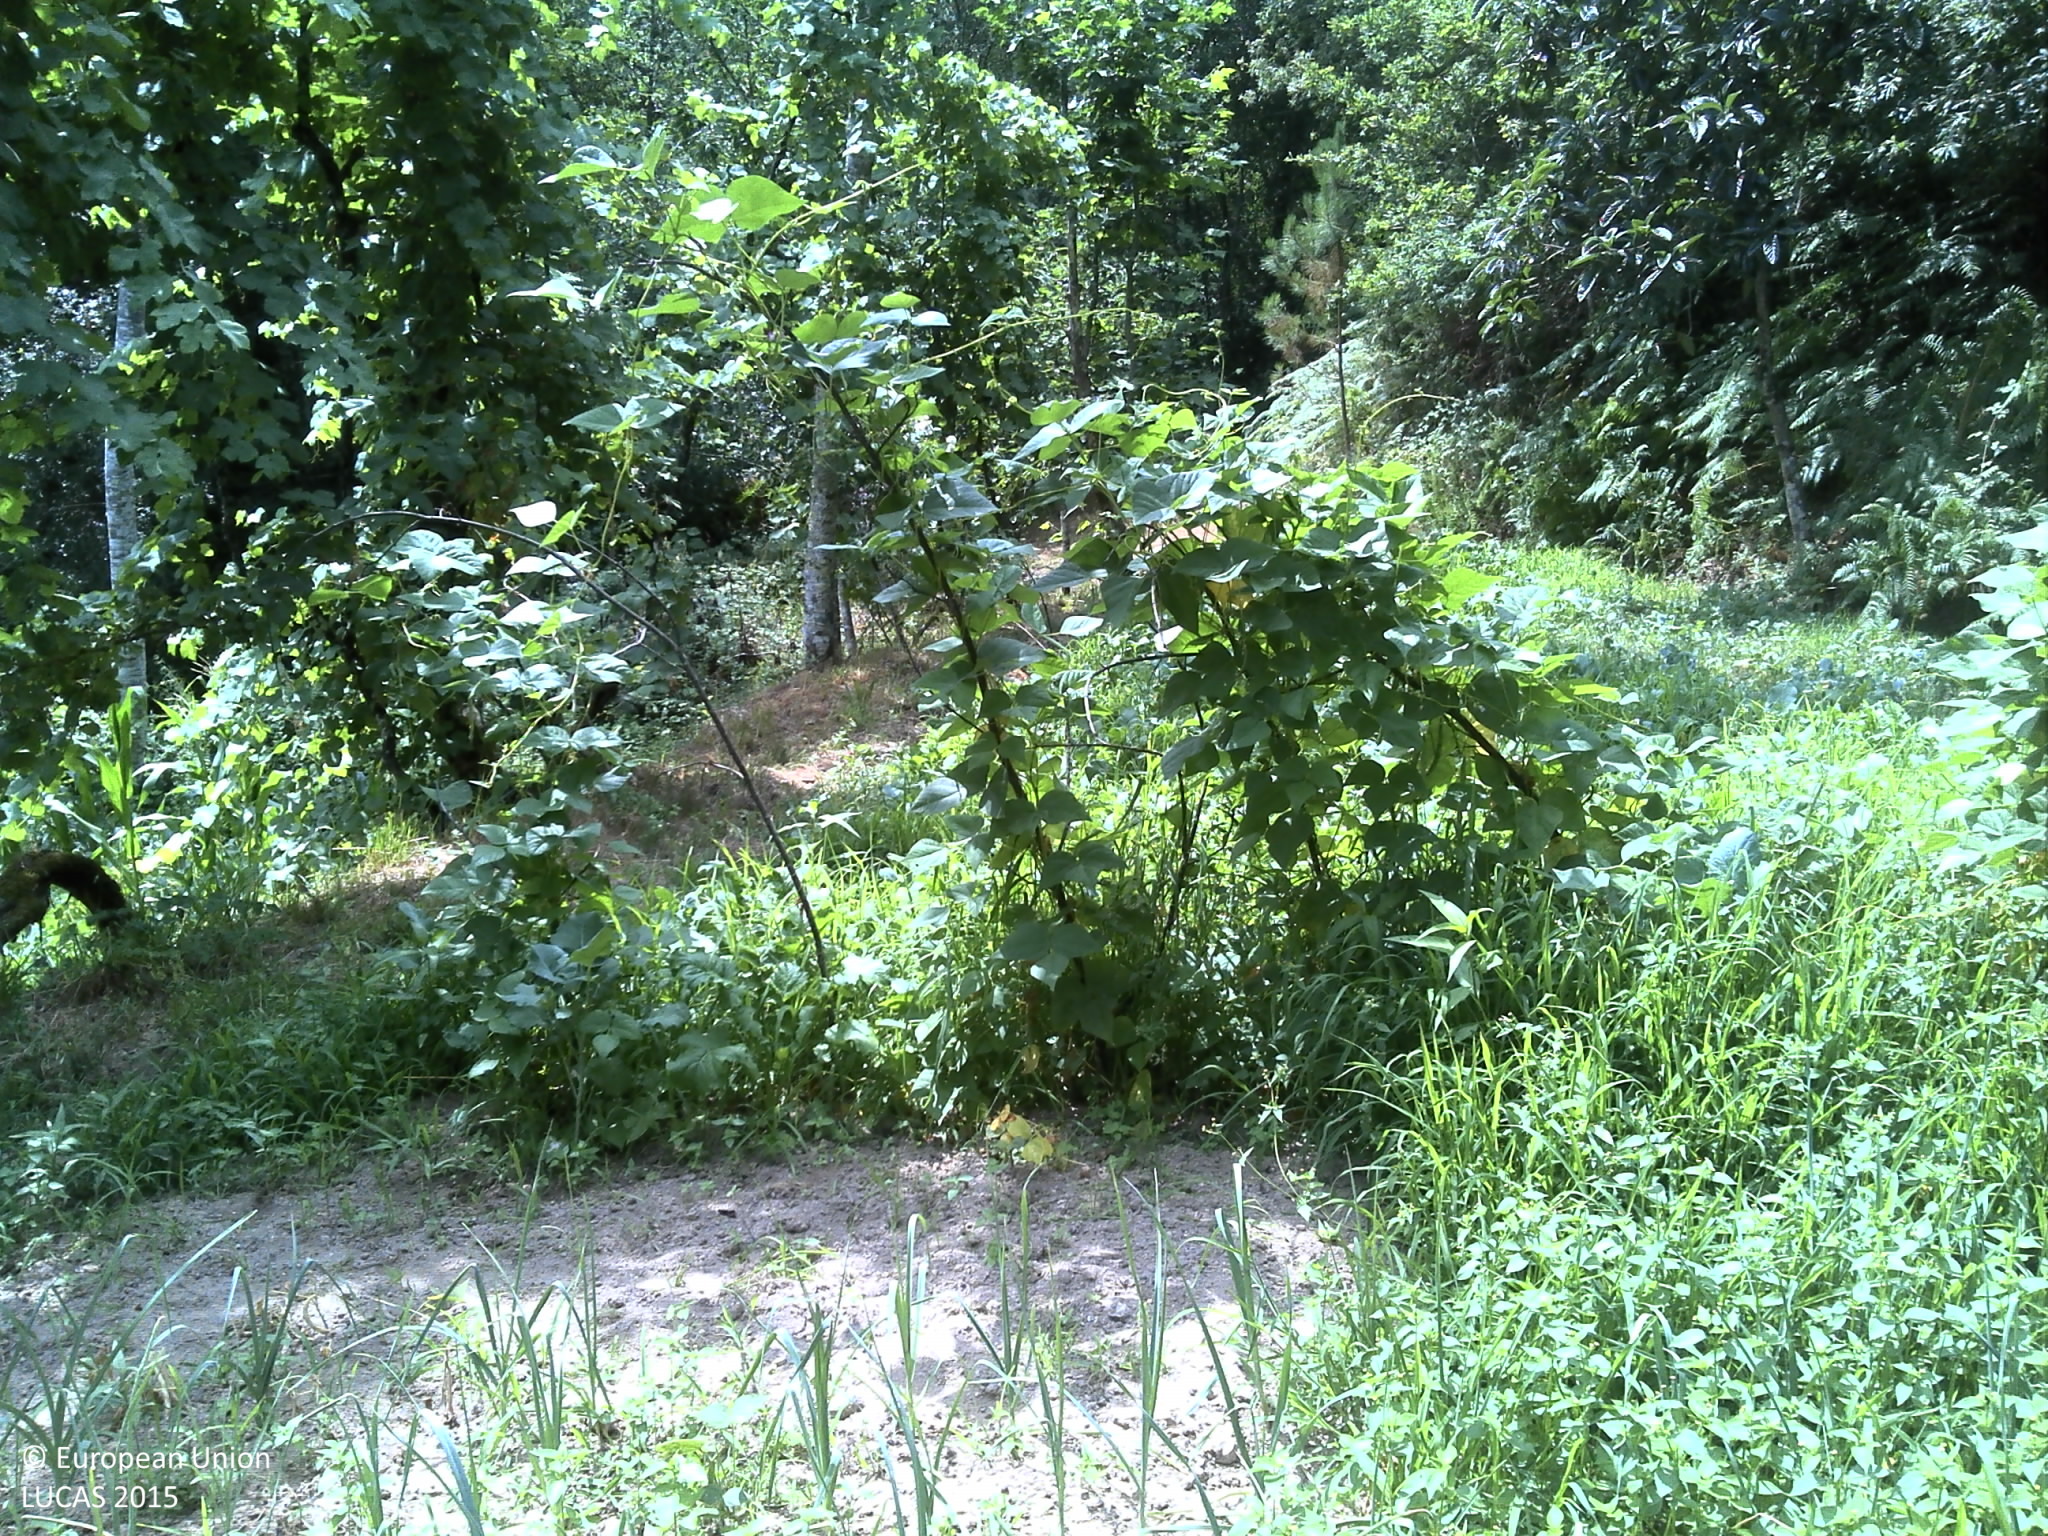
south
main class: Cropland
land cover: Other fresh vegetables
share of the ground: > 75 %
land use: Agriculture (excluding fallow land and kitchen gardens)
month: July
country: PT
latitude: 41.5006
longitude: -8.0271
